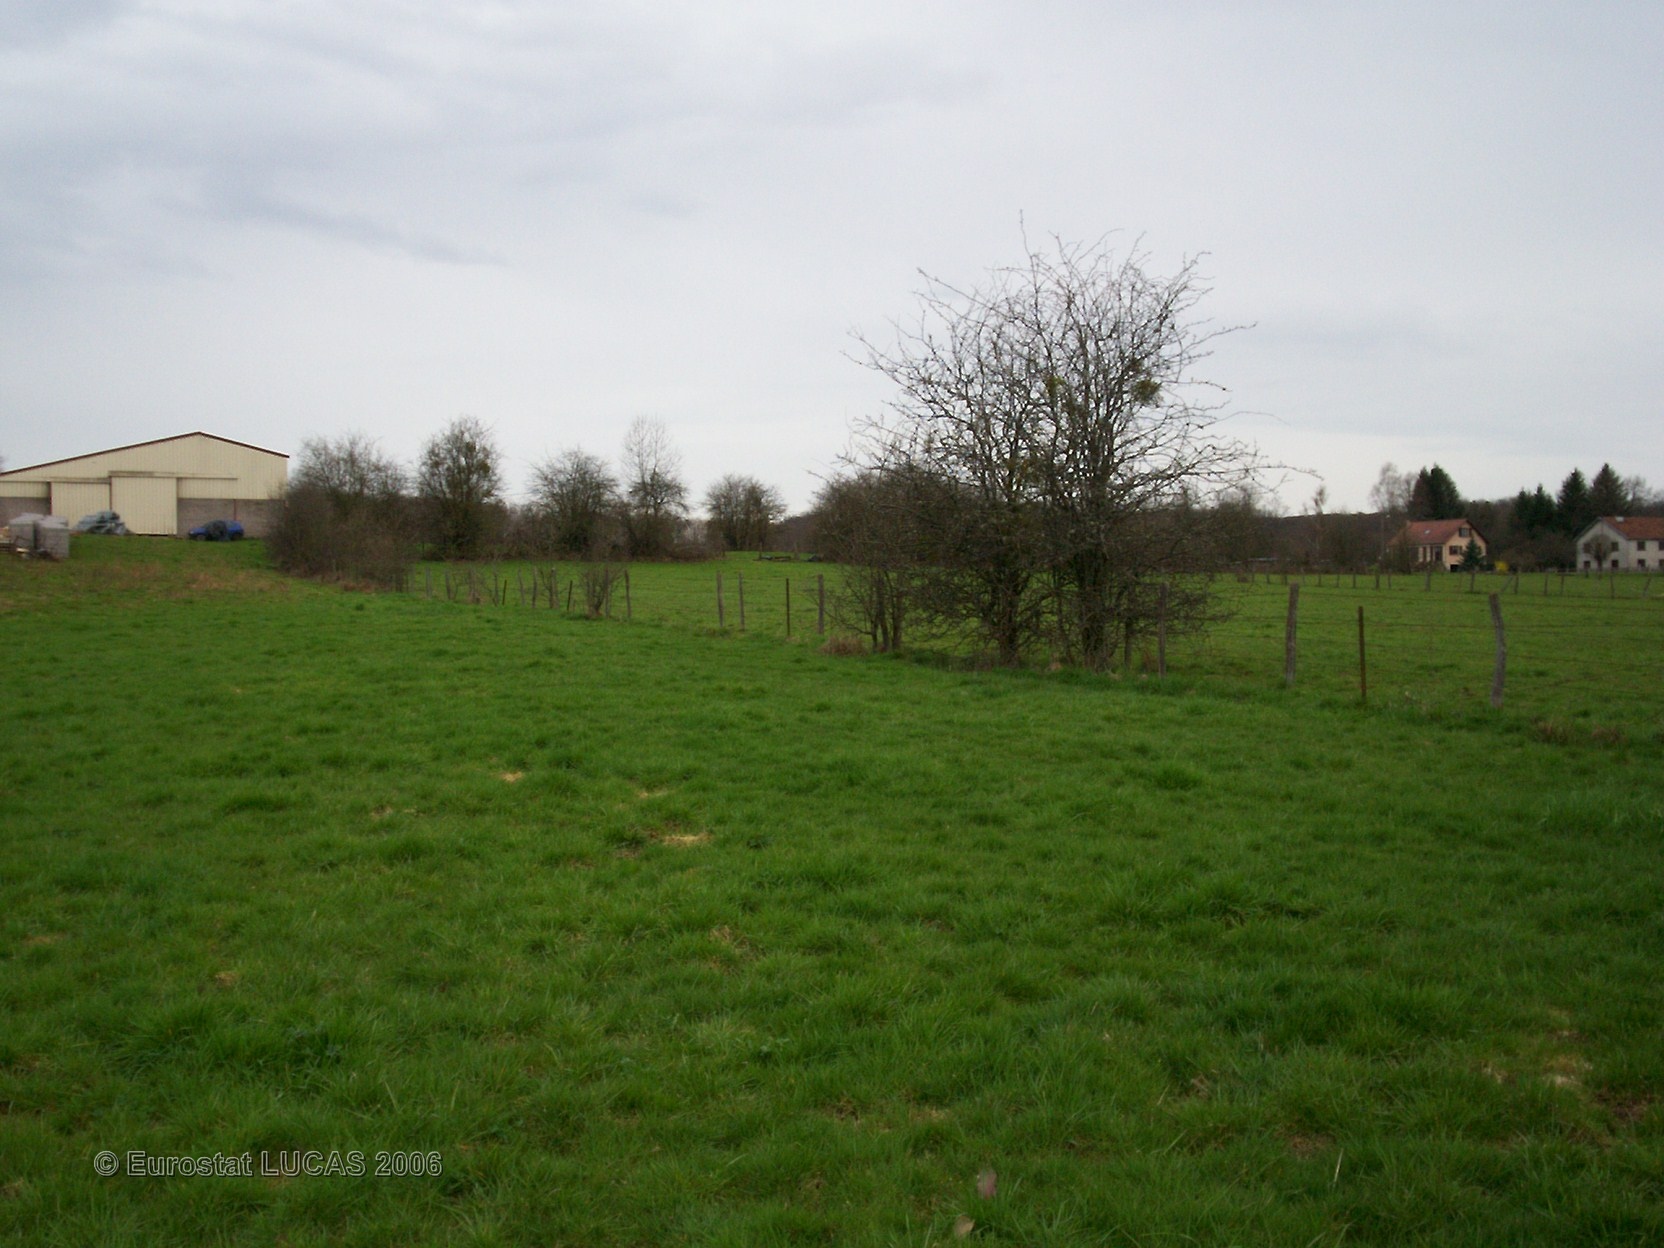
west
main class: Grassland
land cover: Grassland without tree/shrub cover
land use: Agriculture (excluding fallow land and kitchen gardens)
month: April
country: FR
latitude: 47.9621
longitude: 6.2643
